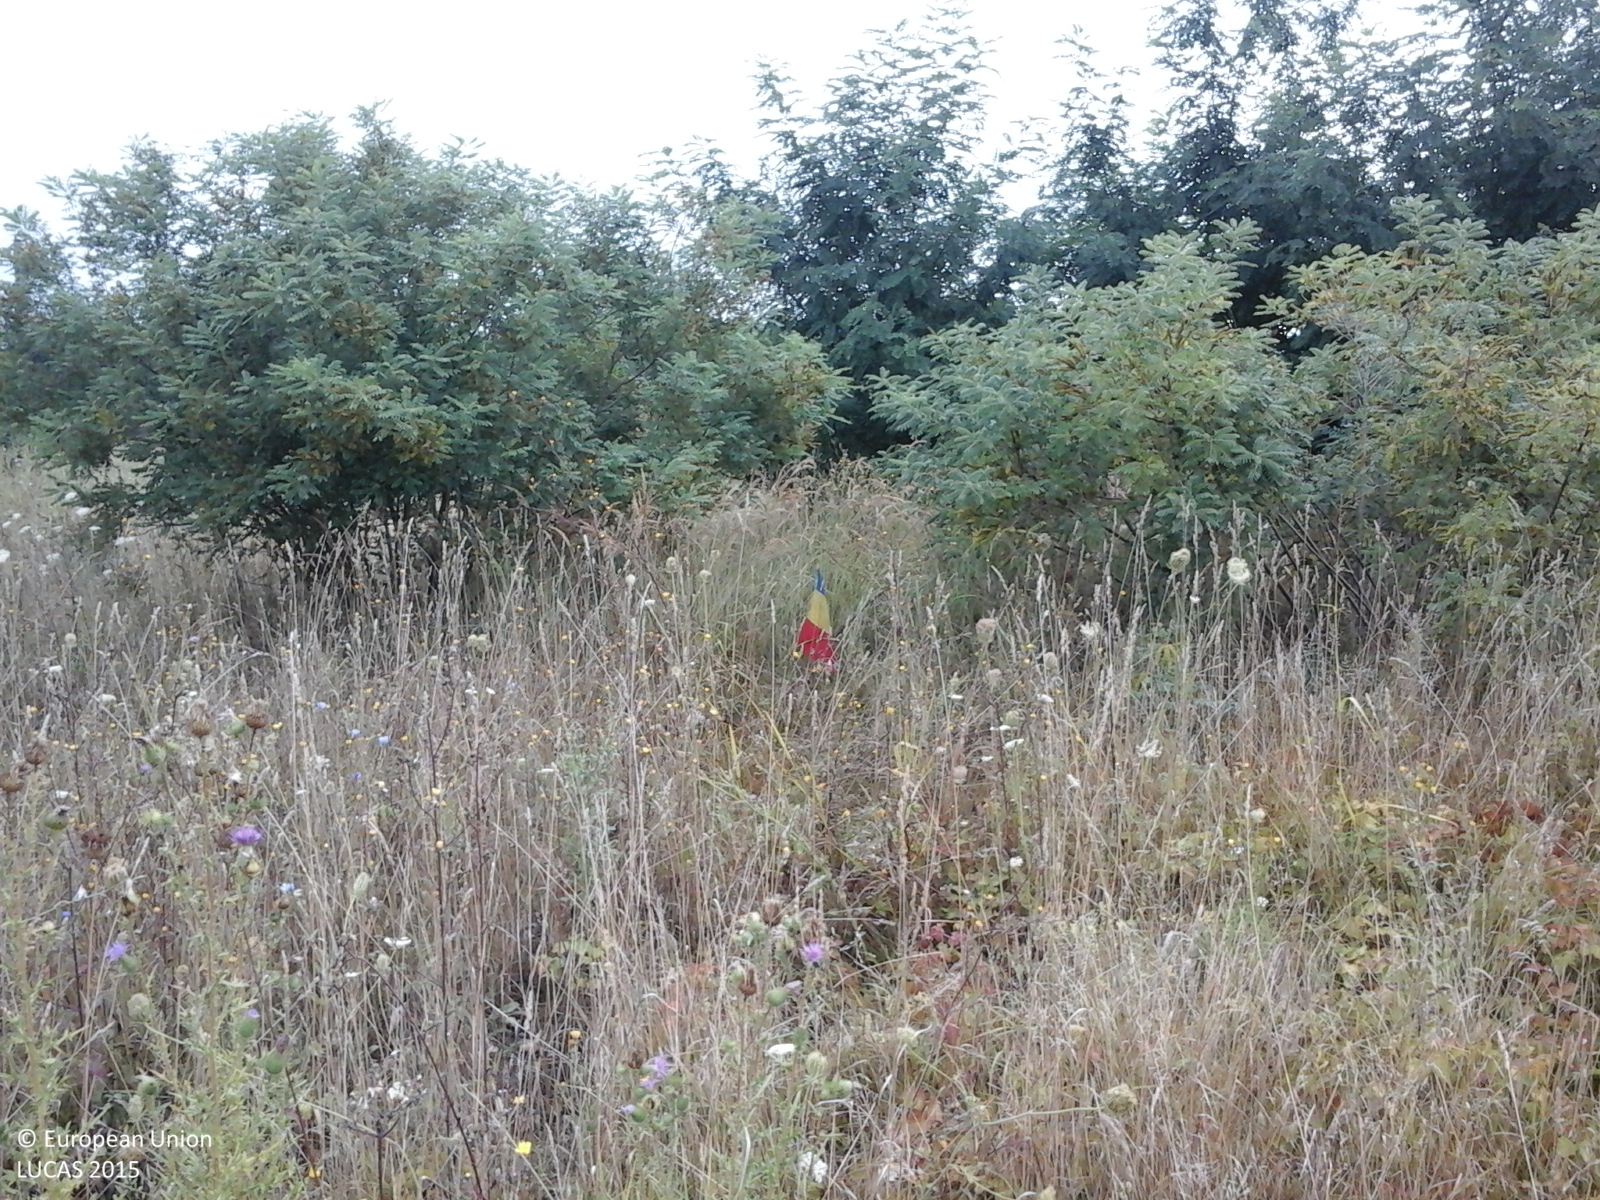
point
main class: Grassland
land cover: Grassland with sparse tree/shrub cover
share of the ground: > 75 %
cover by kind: herbaceous plants 90 %, broadleaved forest trees 5 %, shrubs 5 %
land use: Agriculture (excluding fallow land and kitchen gardens)
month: August
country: RO
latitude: 45.7753
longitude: 20.7122
